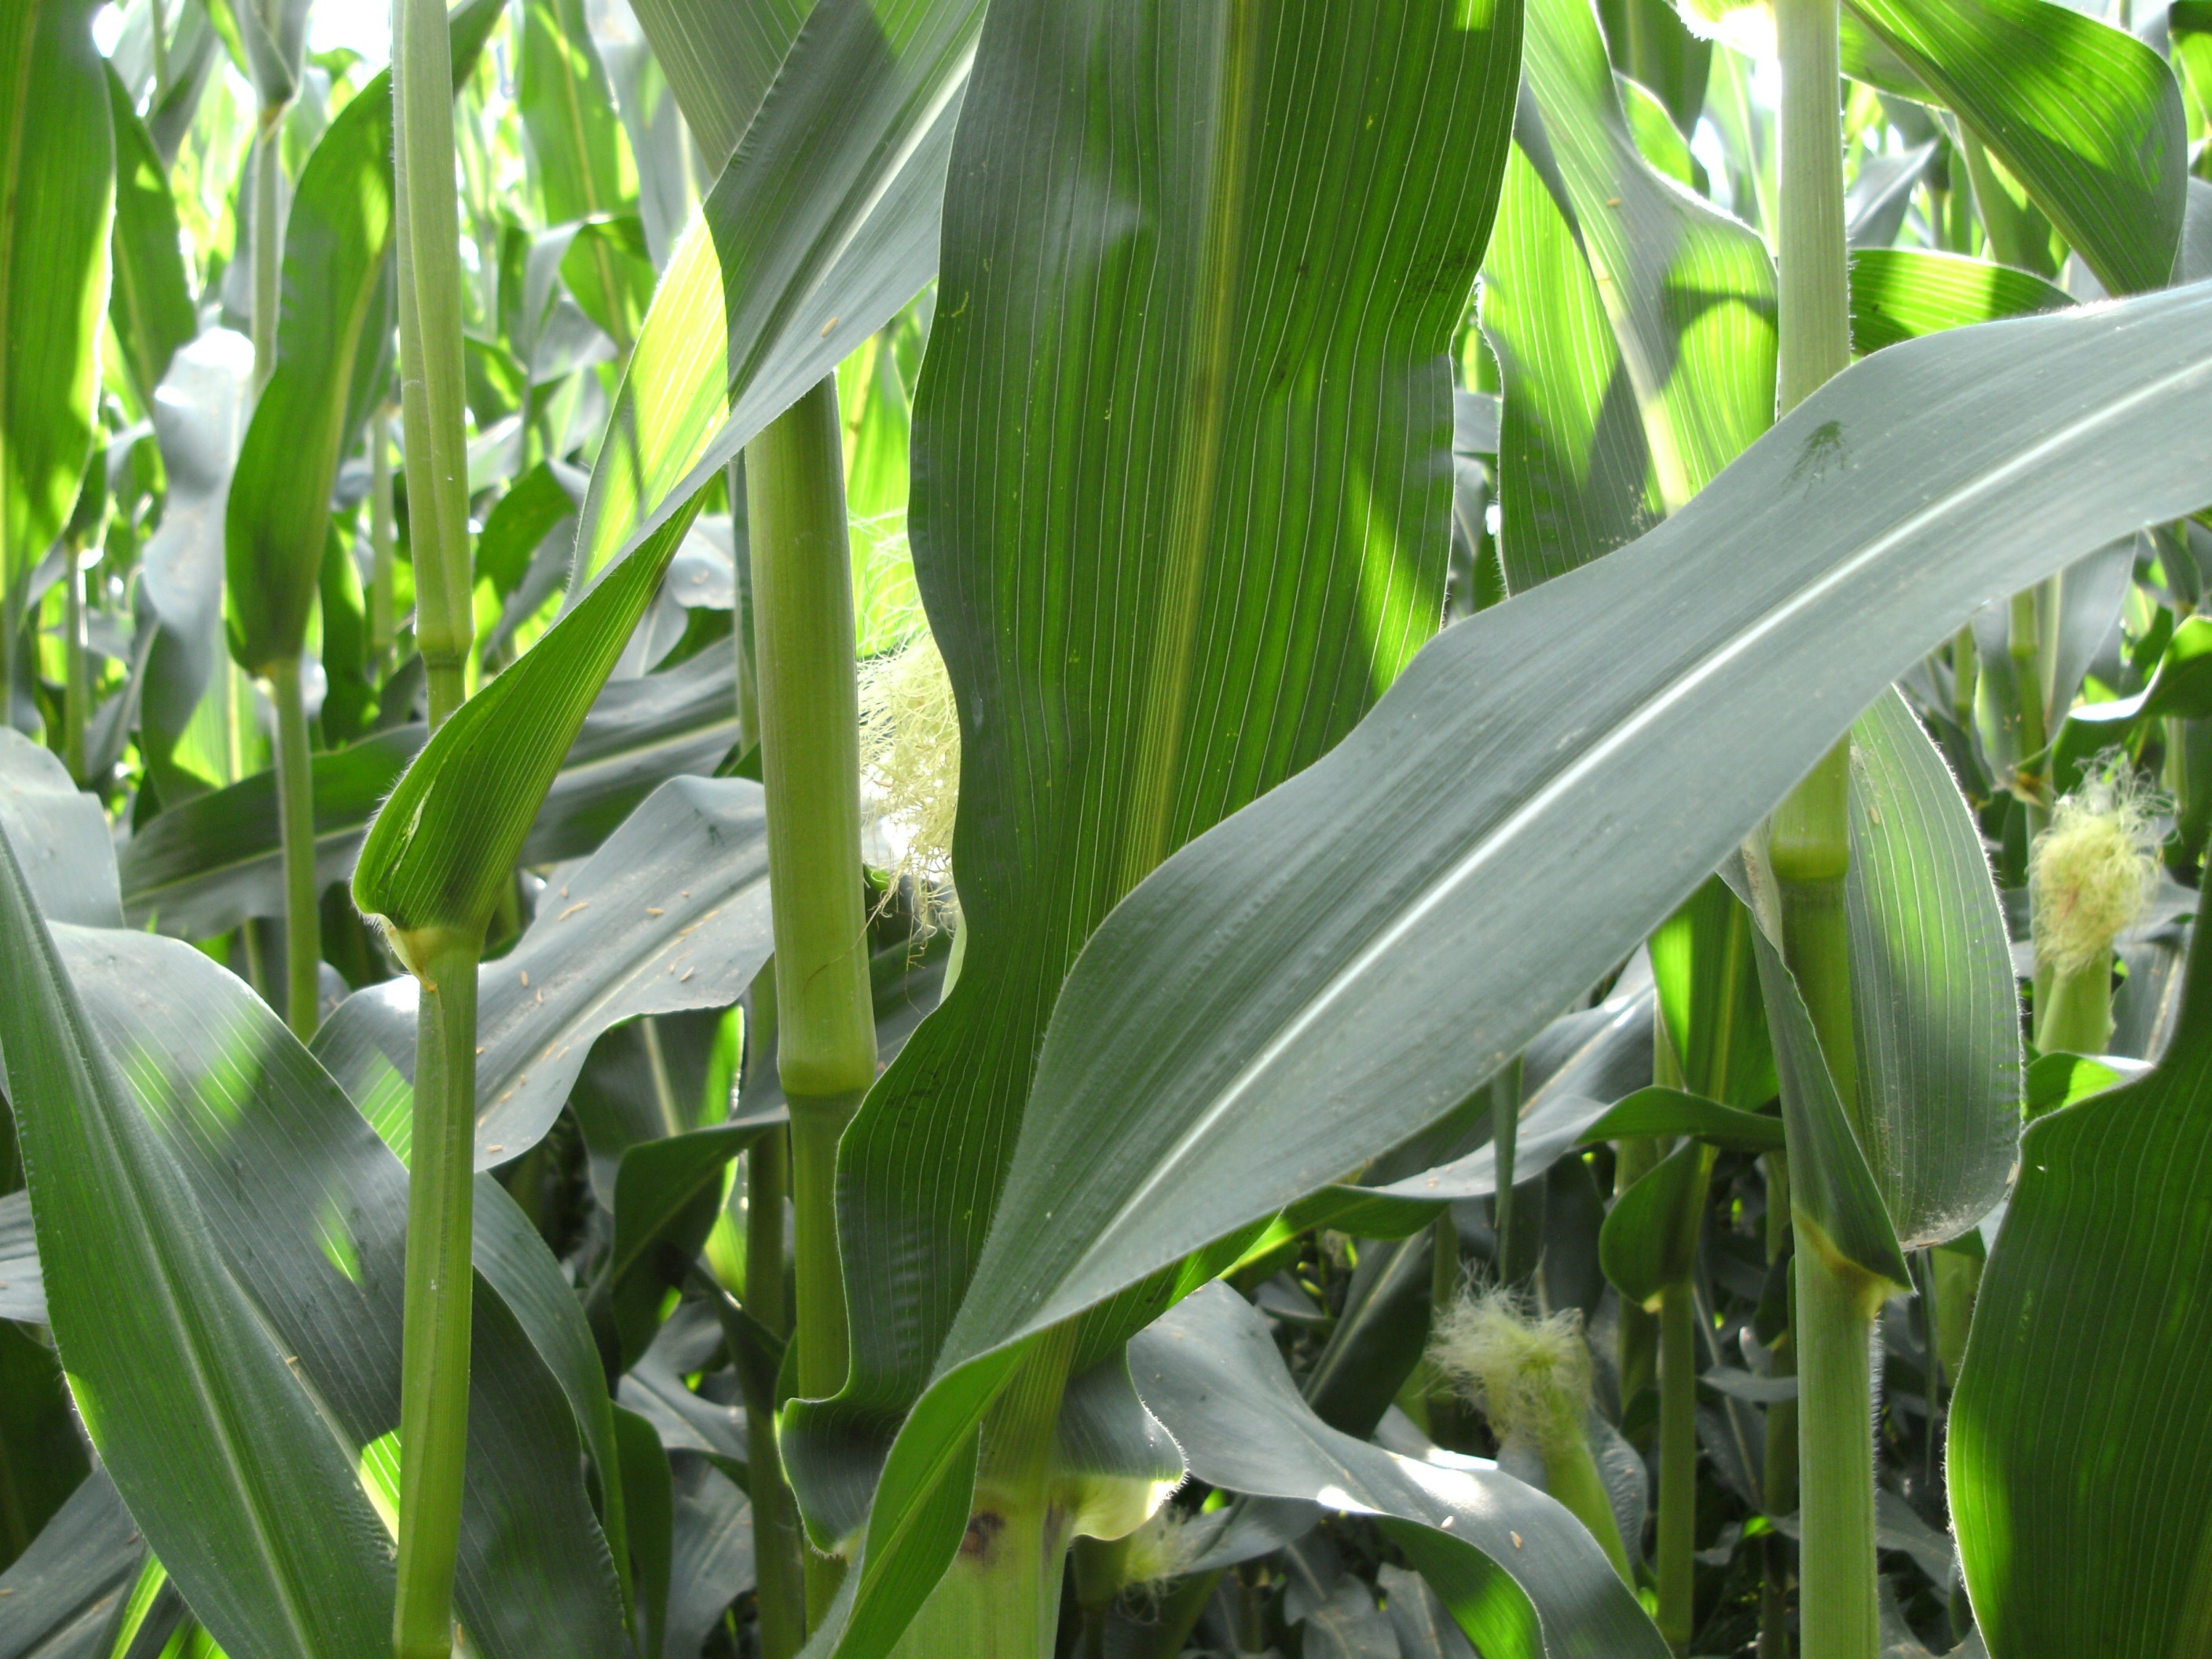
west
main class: Cropland
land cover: Maize
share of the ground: > 75 %
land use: Agriculture (excluding fallow land and kitchen gardens)
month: July
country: AT
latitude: 46.7473
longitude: 14.8283
